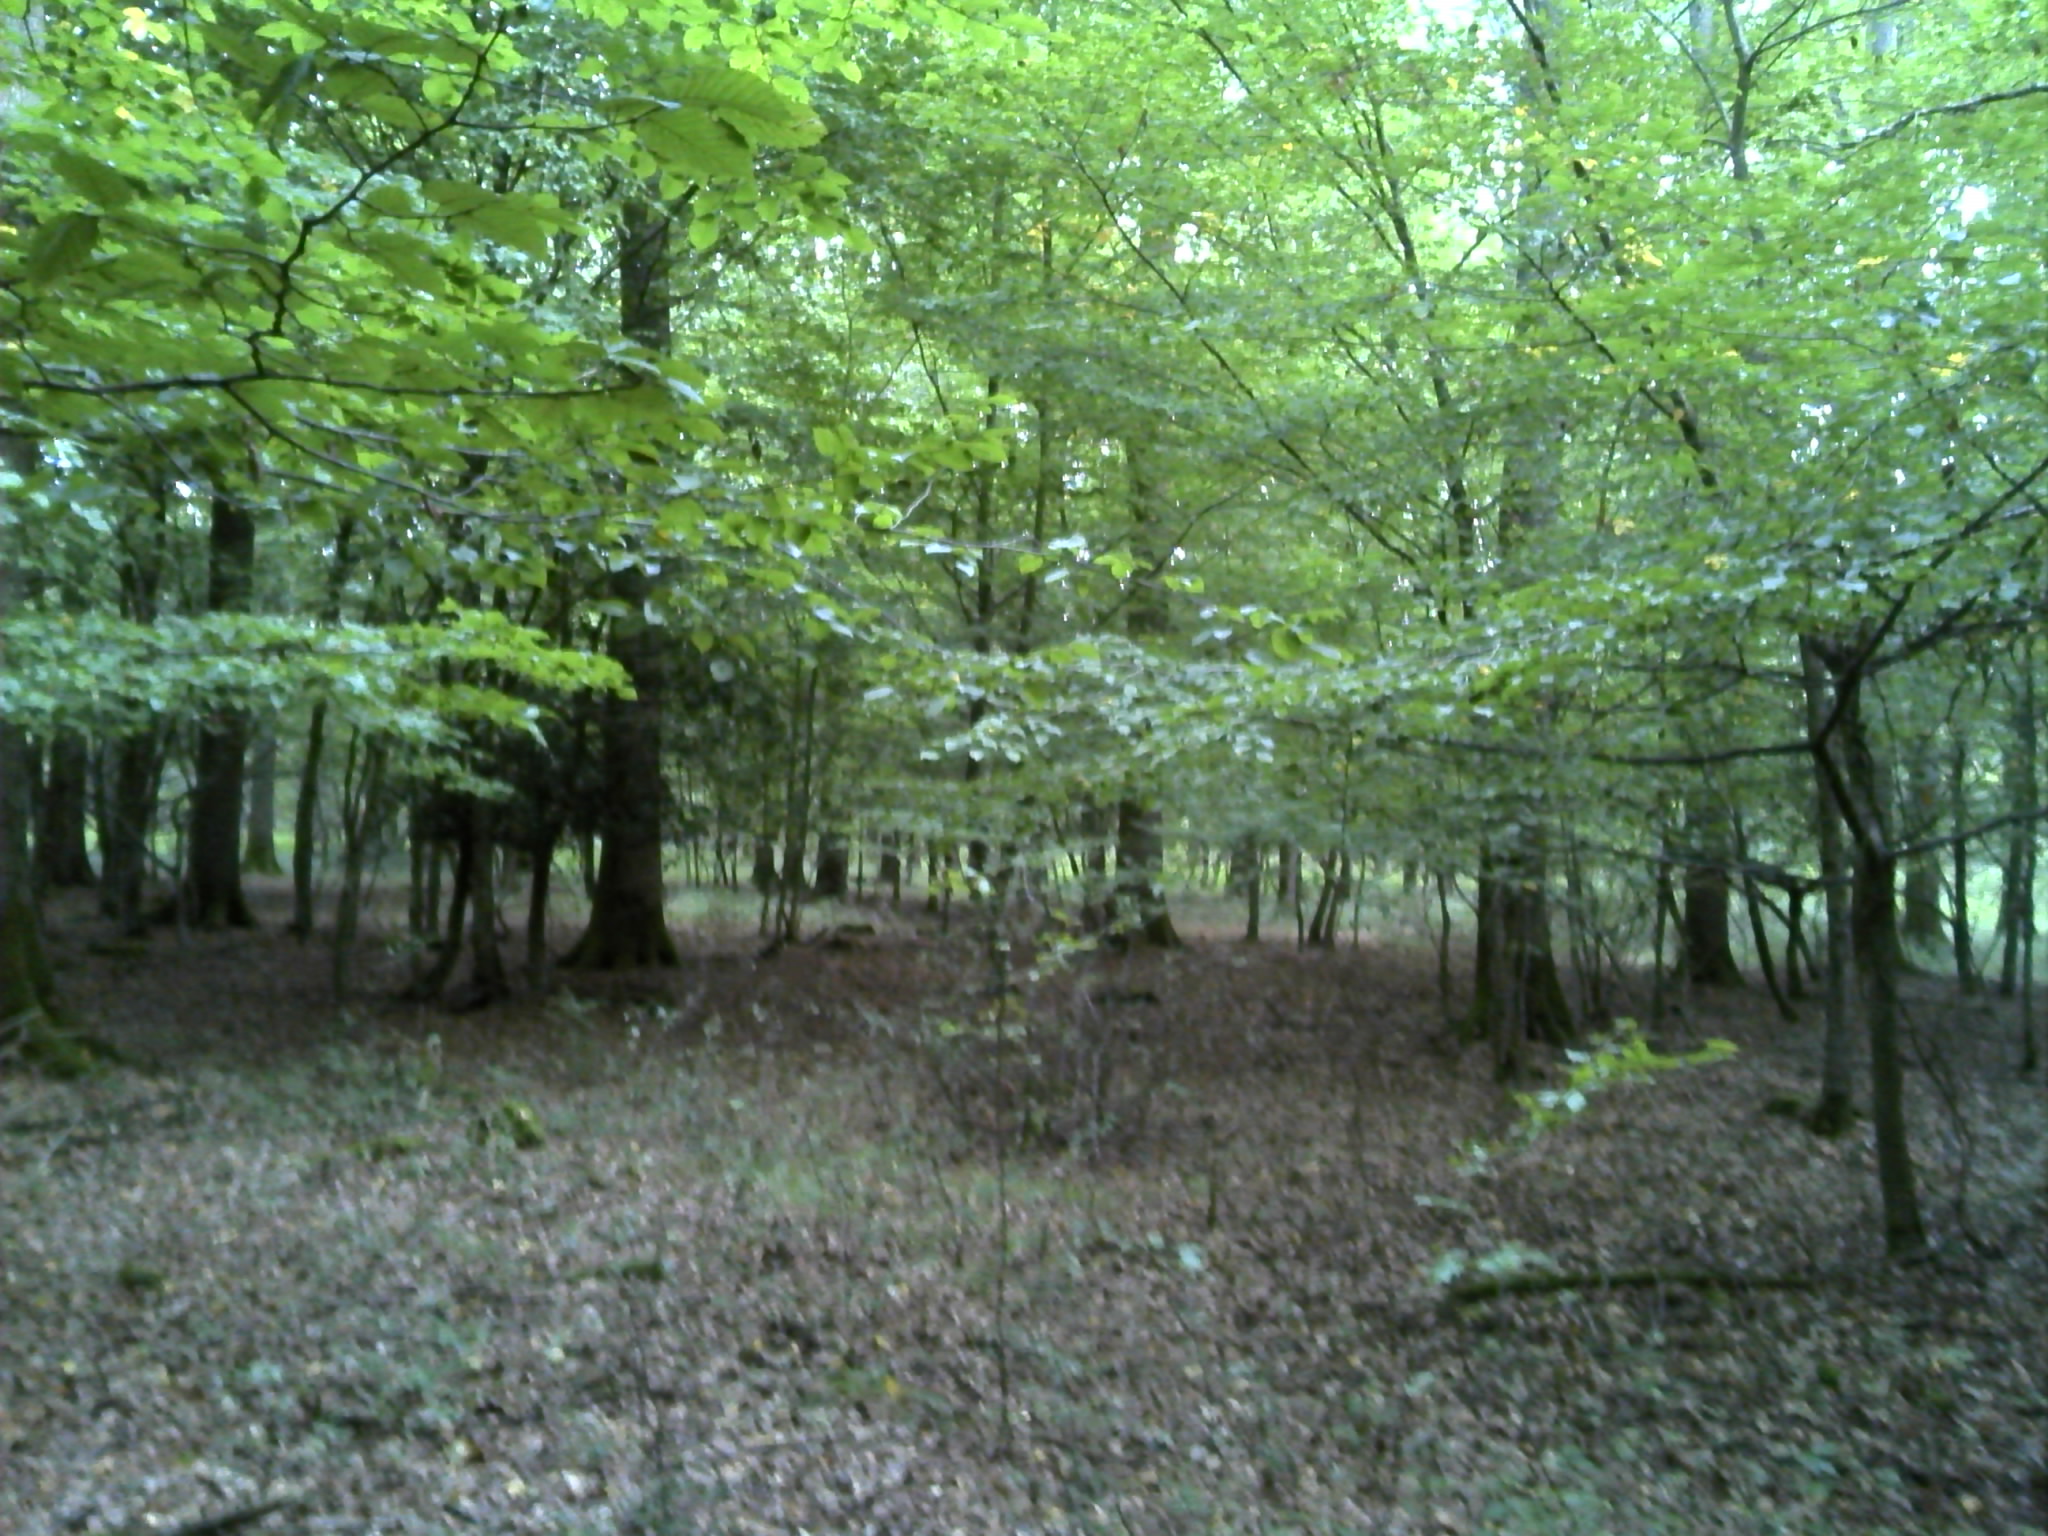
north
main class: Woodland
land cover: Broadleaved woodland
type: mesophytic deciduous forest
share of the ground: > 75 %
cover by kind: broadleaved forest trees 90 %, herbaceous plants 5 %, lichens and mosses 5 %
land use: Forestry
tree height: > 5 m
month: September
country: FR
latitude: 47.9696
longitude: 0.6419
